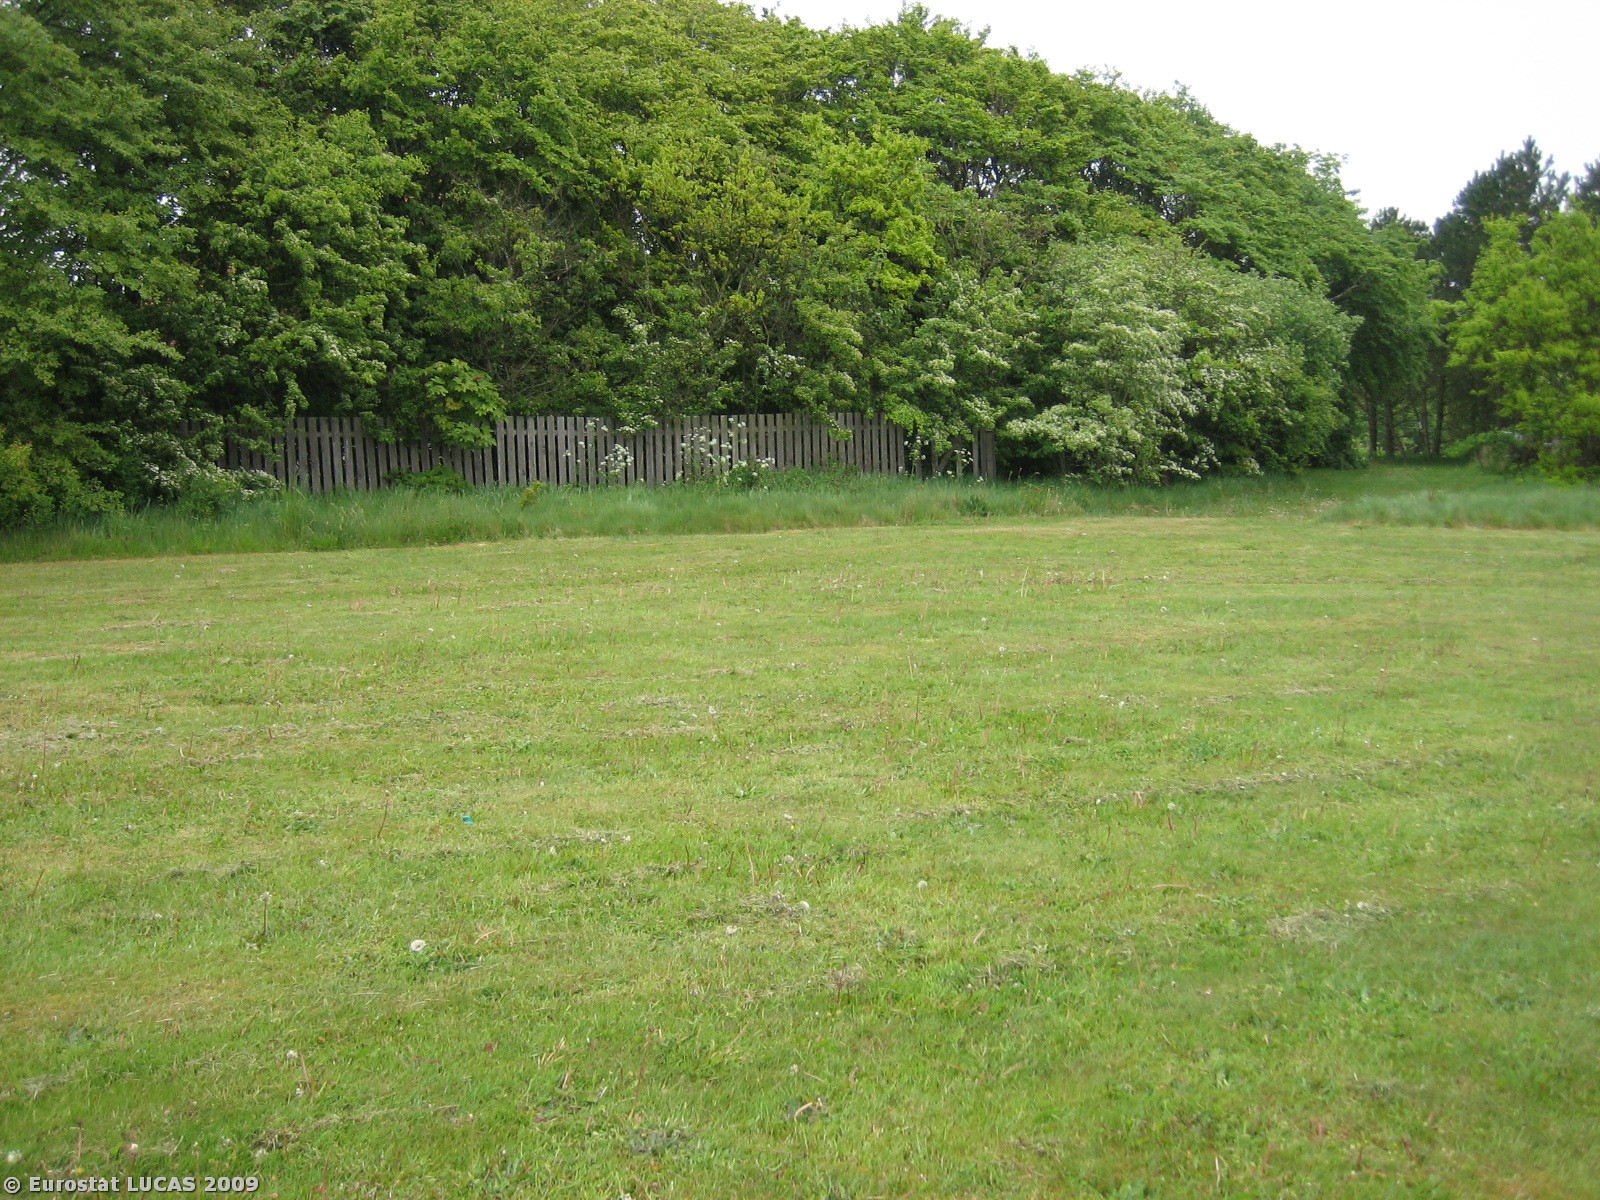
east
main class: Grassland
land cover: Grassland without tree/shrub cover
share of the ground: > 75 %
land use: Commerce, finance, business
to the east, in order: Grassland without tree/shrub cover; Fences; Broadleaved woodland; Artificial constructions in urban areas; Single bushes/trees; Grassland without tree/shrub cover; Broadleaved woodland; Grassland without tree/shrub cover; Broadleaved woodland; Managed hedges; Grass margins; Paved roads, cycling and walking lanes; Broadleaved woodland; Inland water bodies; Broadleaved woodland; Coniferous woodland; Barley
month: May
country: DK
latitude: 56.0864
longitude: 8.2823
